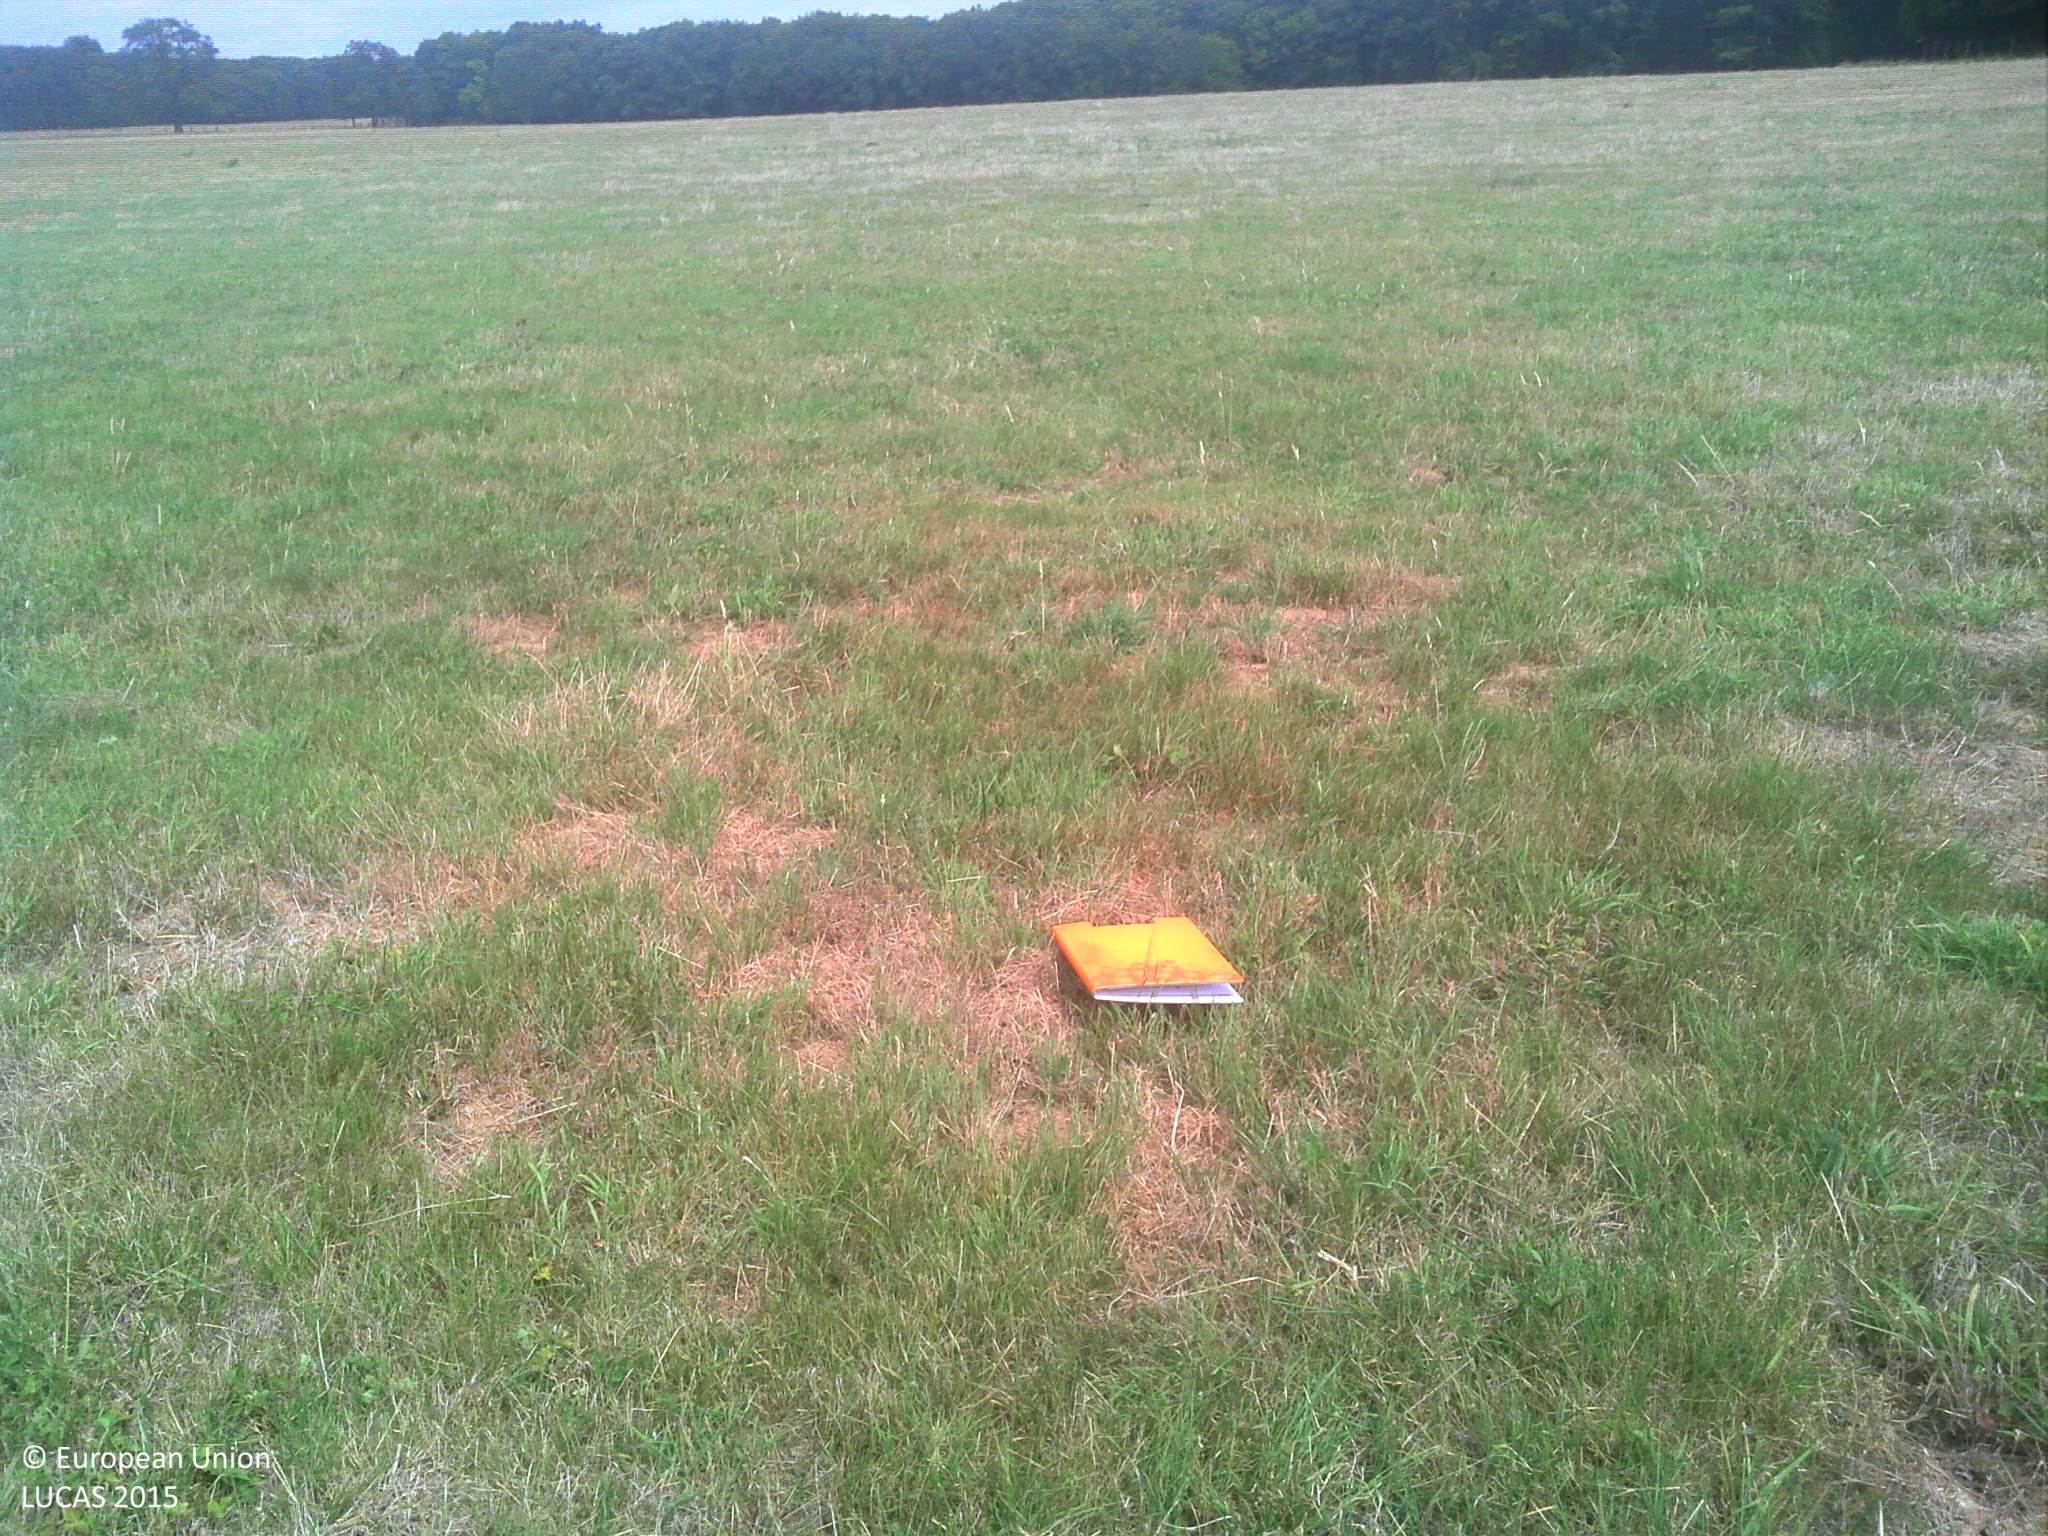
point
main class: Grassland
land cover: Grassland without tree/shrub cover
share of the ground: > 75 %
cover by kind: herbaceous plants 100 %
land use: Agriculture (excluding fallow land and kitchen gardens)
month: July
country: FR
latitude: 48.0965
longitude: 5.0981
